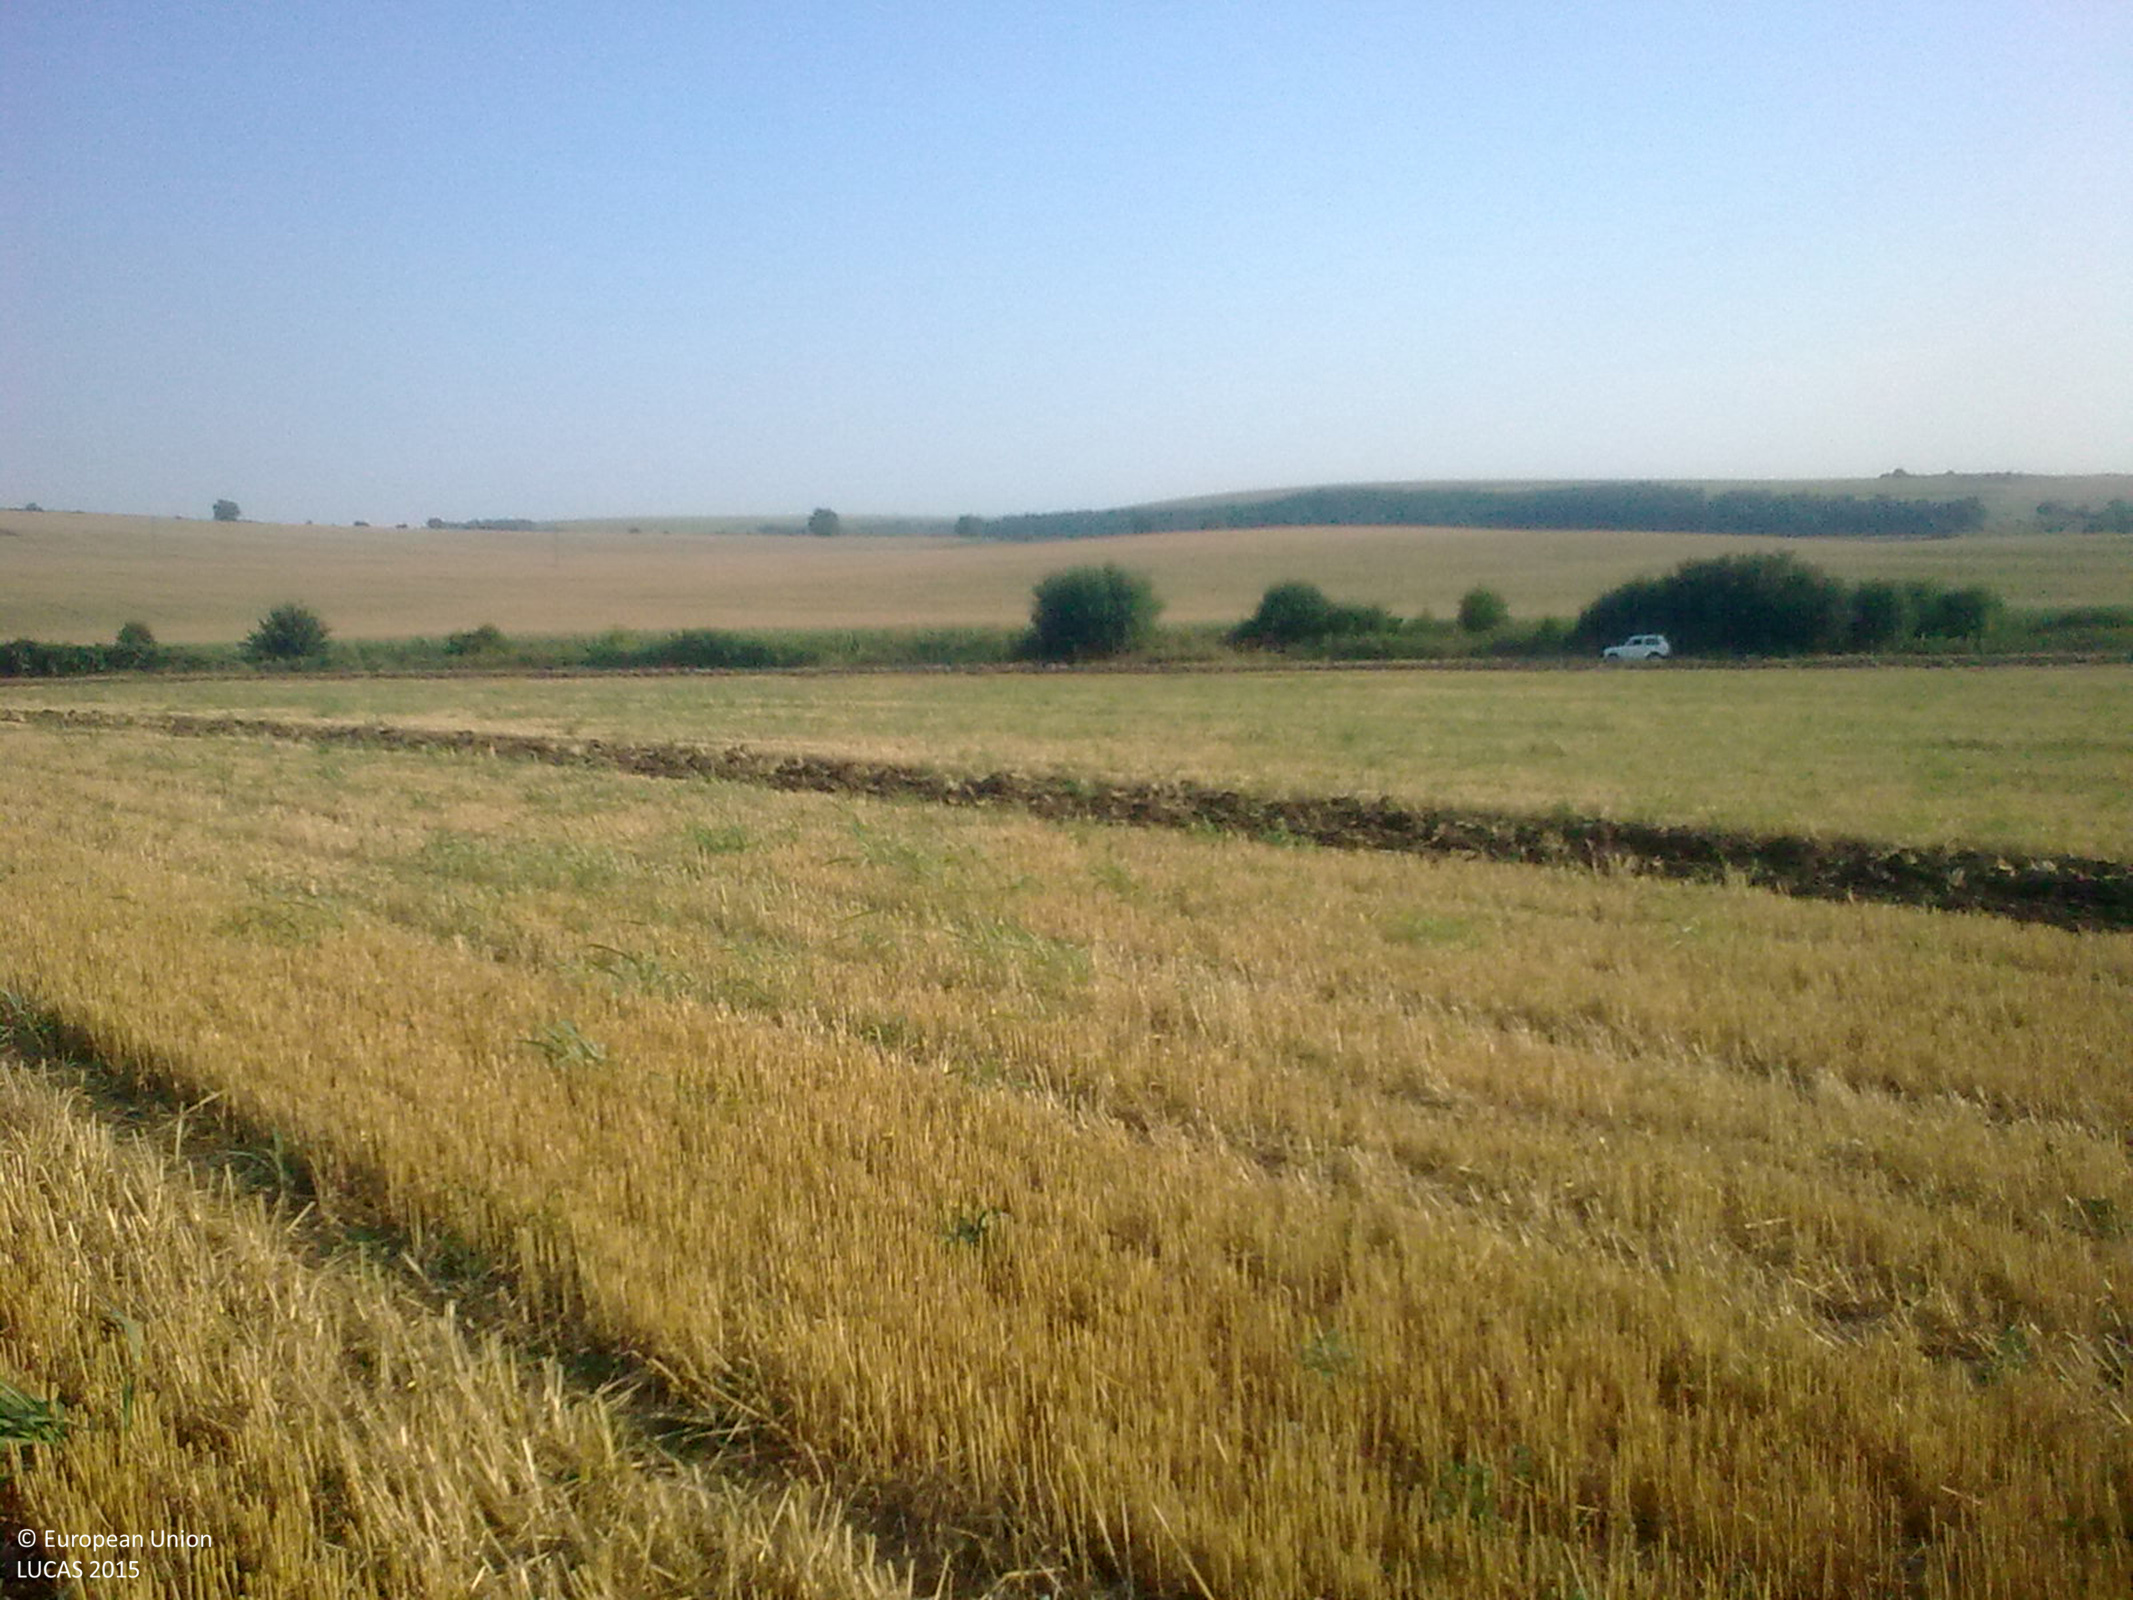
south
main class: Cropland
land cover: Common wheat
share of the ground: 50 - 75 %
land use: Agriculture (excluding fallow land and kitchen gardens)
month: July
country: BG
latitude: 43.8141
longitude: 26.1241
